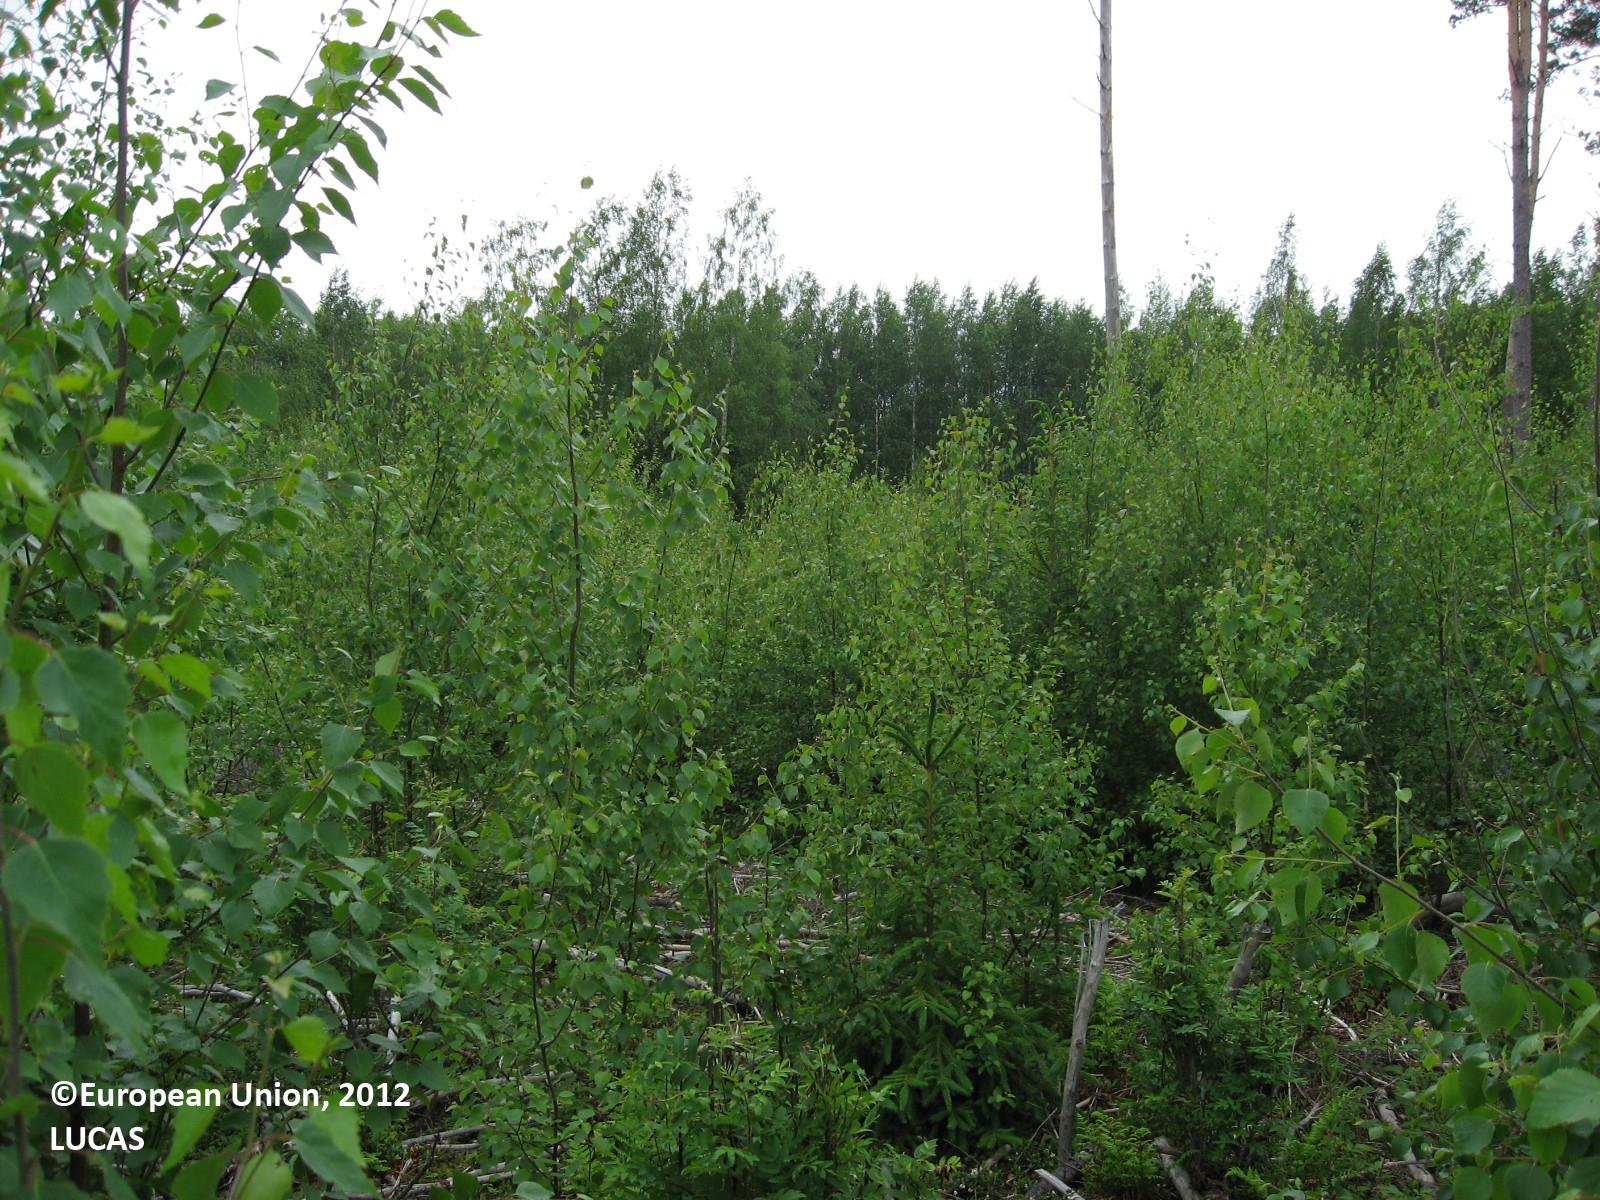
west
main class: Woodland
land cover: Broadleaved woodland
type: boreal forest
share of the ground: > 75 %
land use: Forestry
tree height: > 5 m
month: June
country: FI
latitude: 60.4568
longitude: 26.3144
